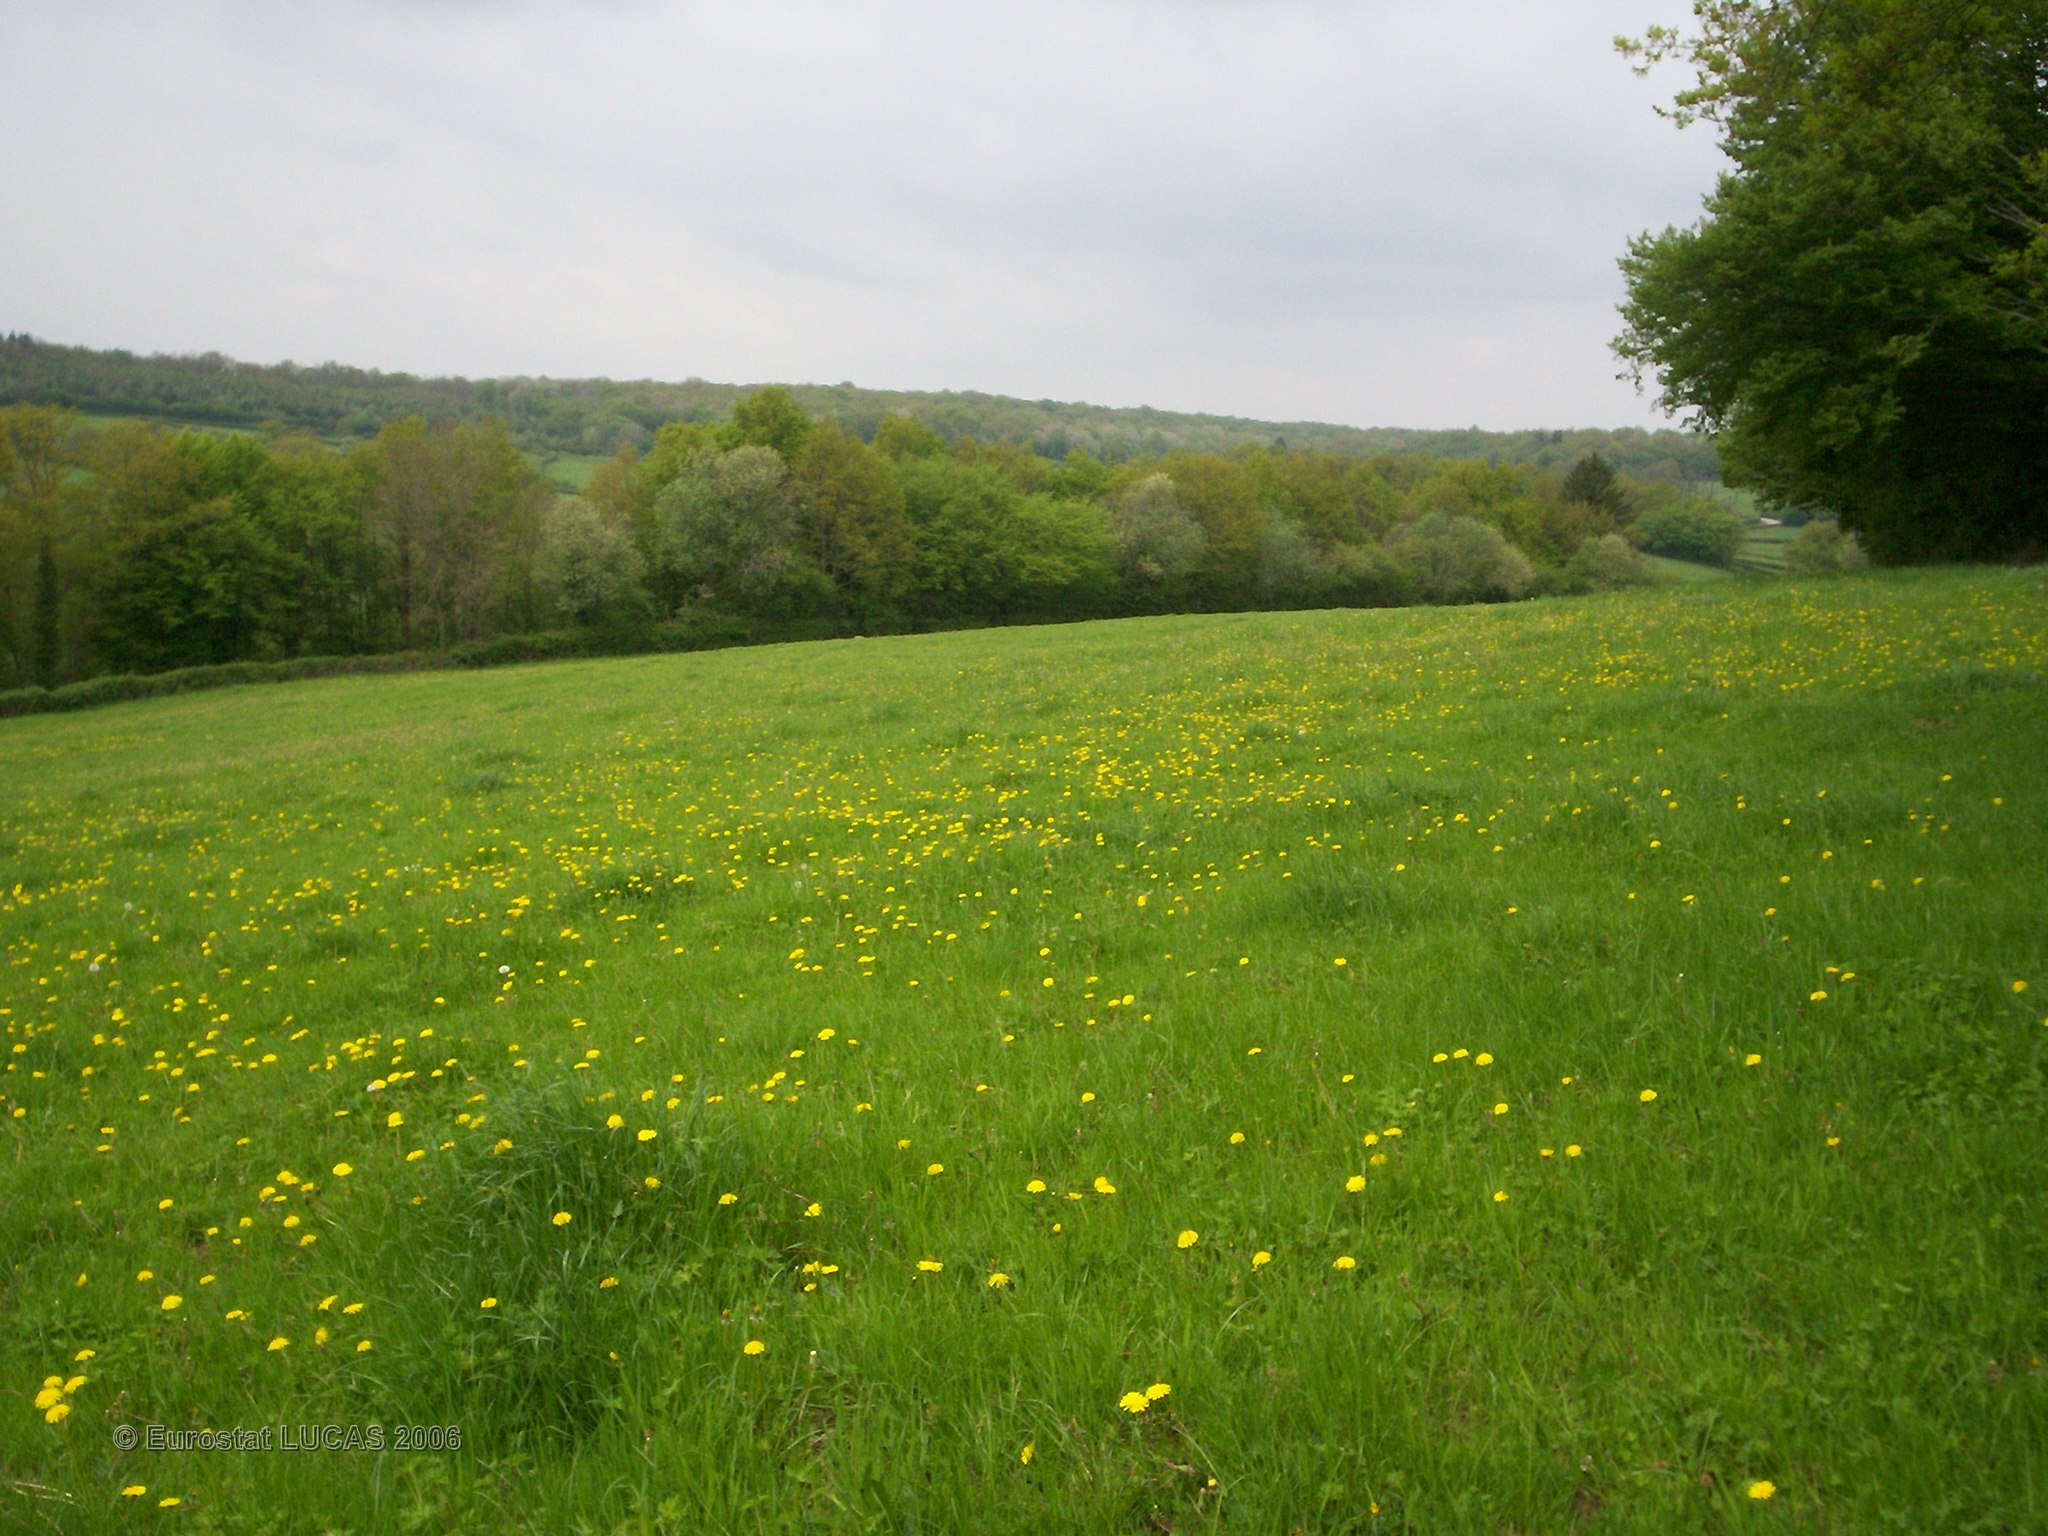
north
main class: Grassland
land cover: Grassland without tree/shrub cover
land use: Agriculture (excluding fallow land and kitchen gardens)
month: May
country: FR
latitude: 47.4043
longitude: 3.8889
